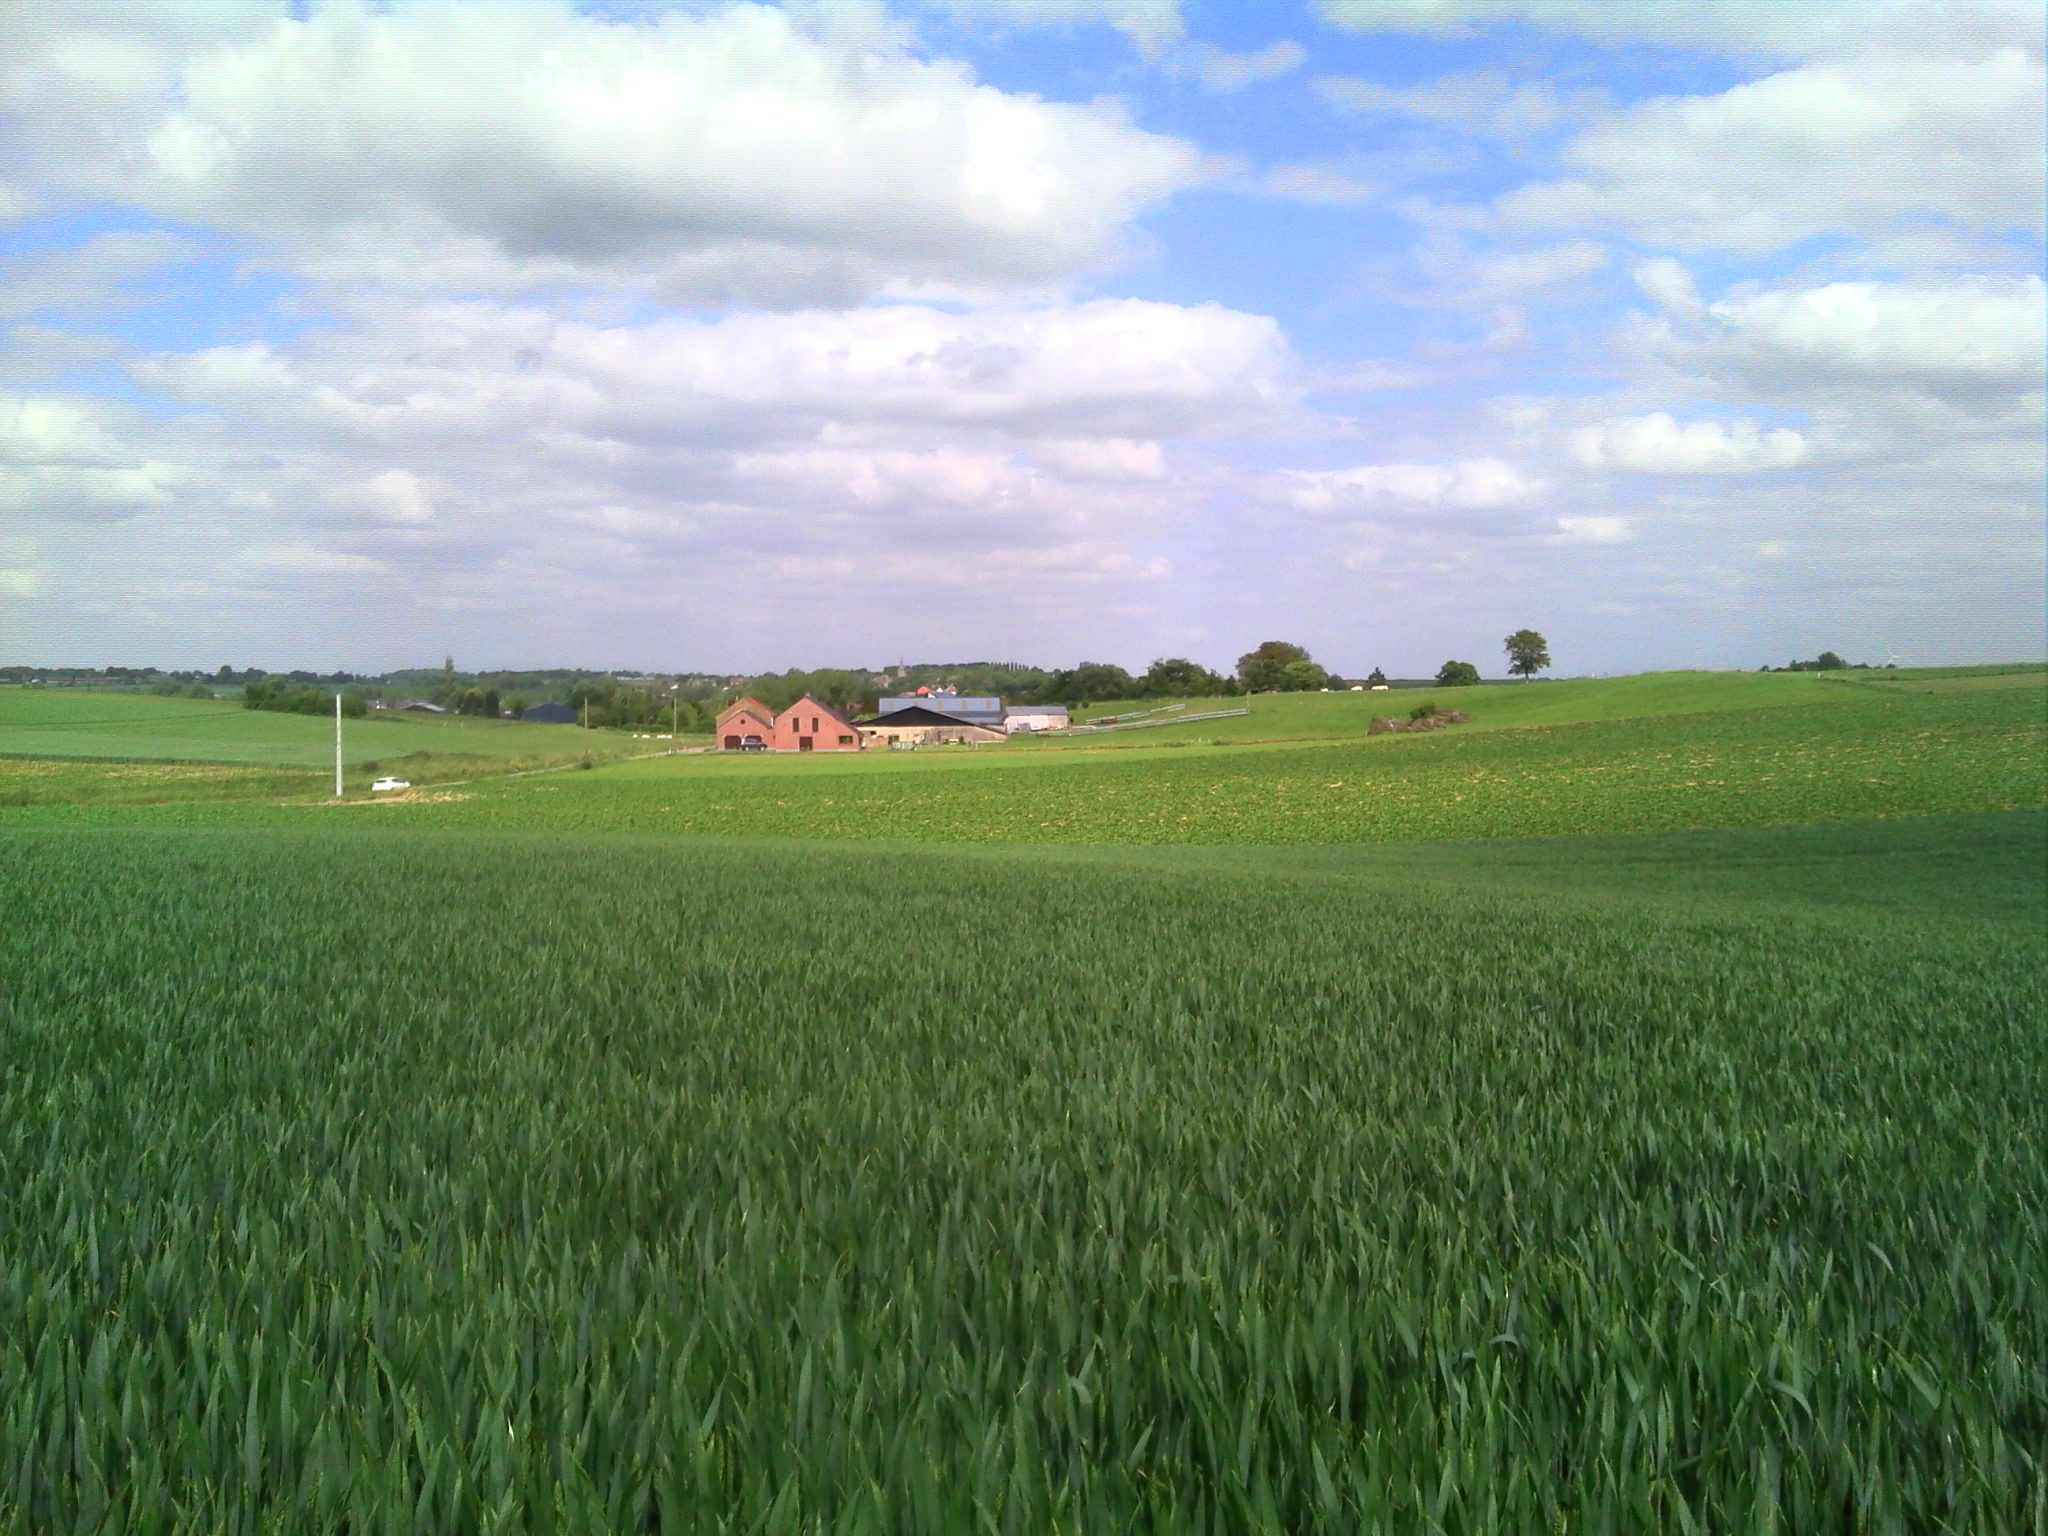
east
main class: Cropland
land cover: Common wheat
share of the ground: > 75 %
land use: Agriculture (excluding fallow land and kitchen gardens)
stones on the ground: < 10 %
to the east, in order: Common wheat; Sugar beet; Maize; Fences; Grassland without tree/shrub cover
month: June
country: BE
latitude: 50.5067
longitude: 4.5957
